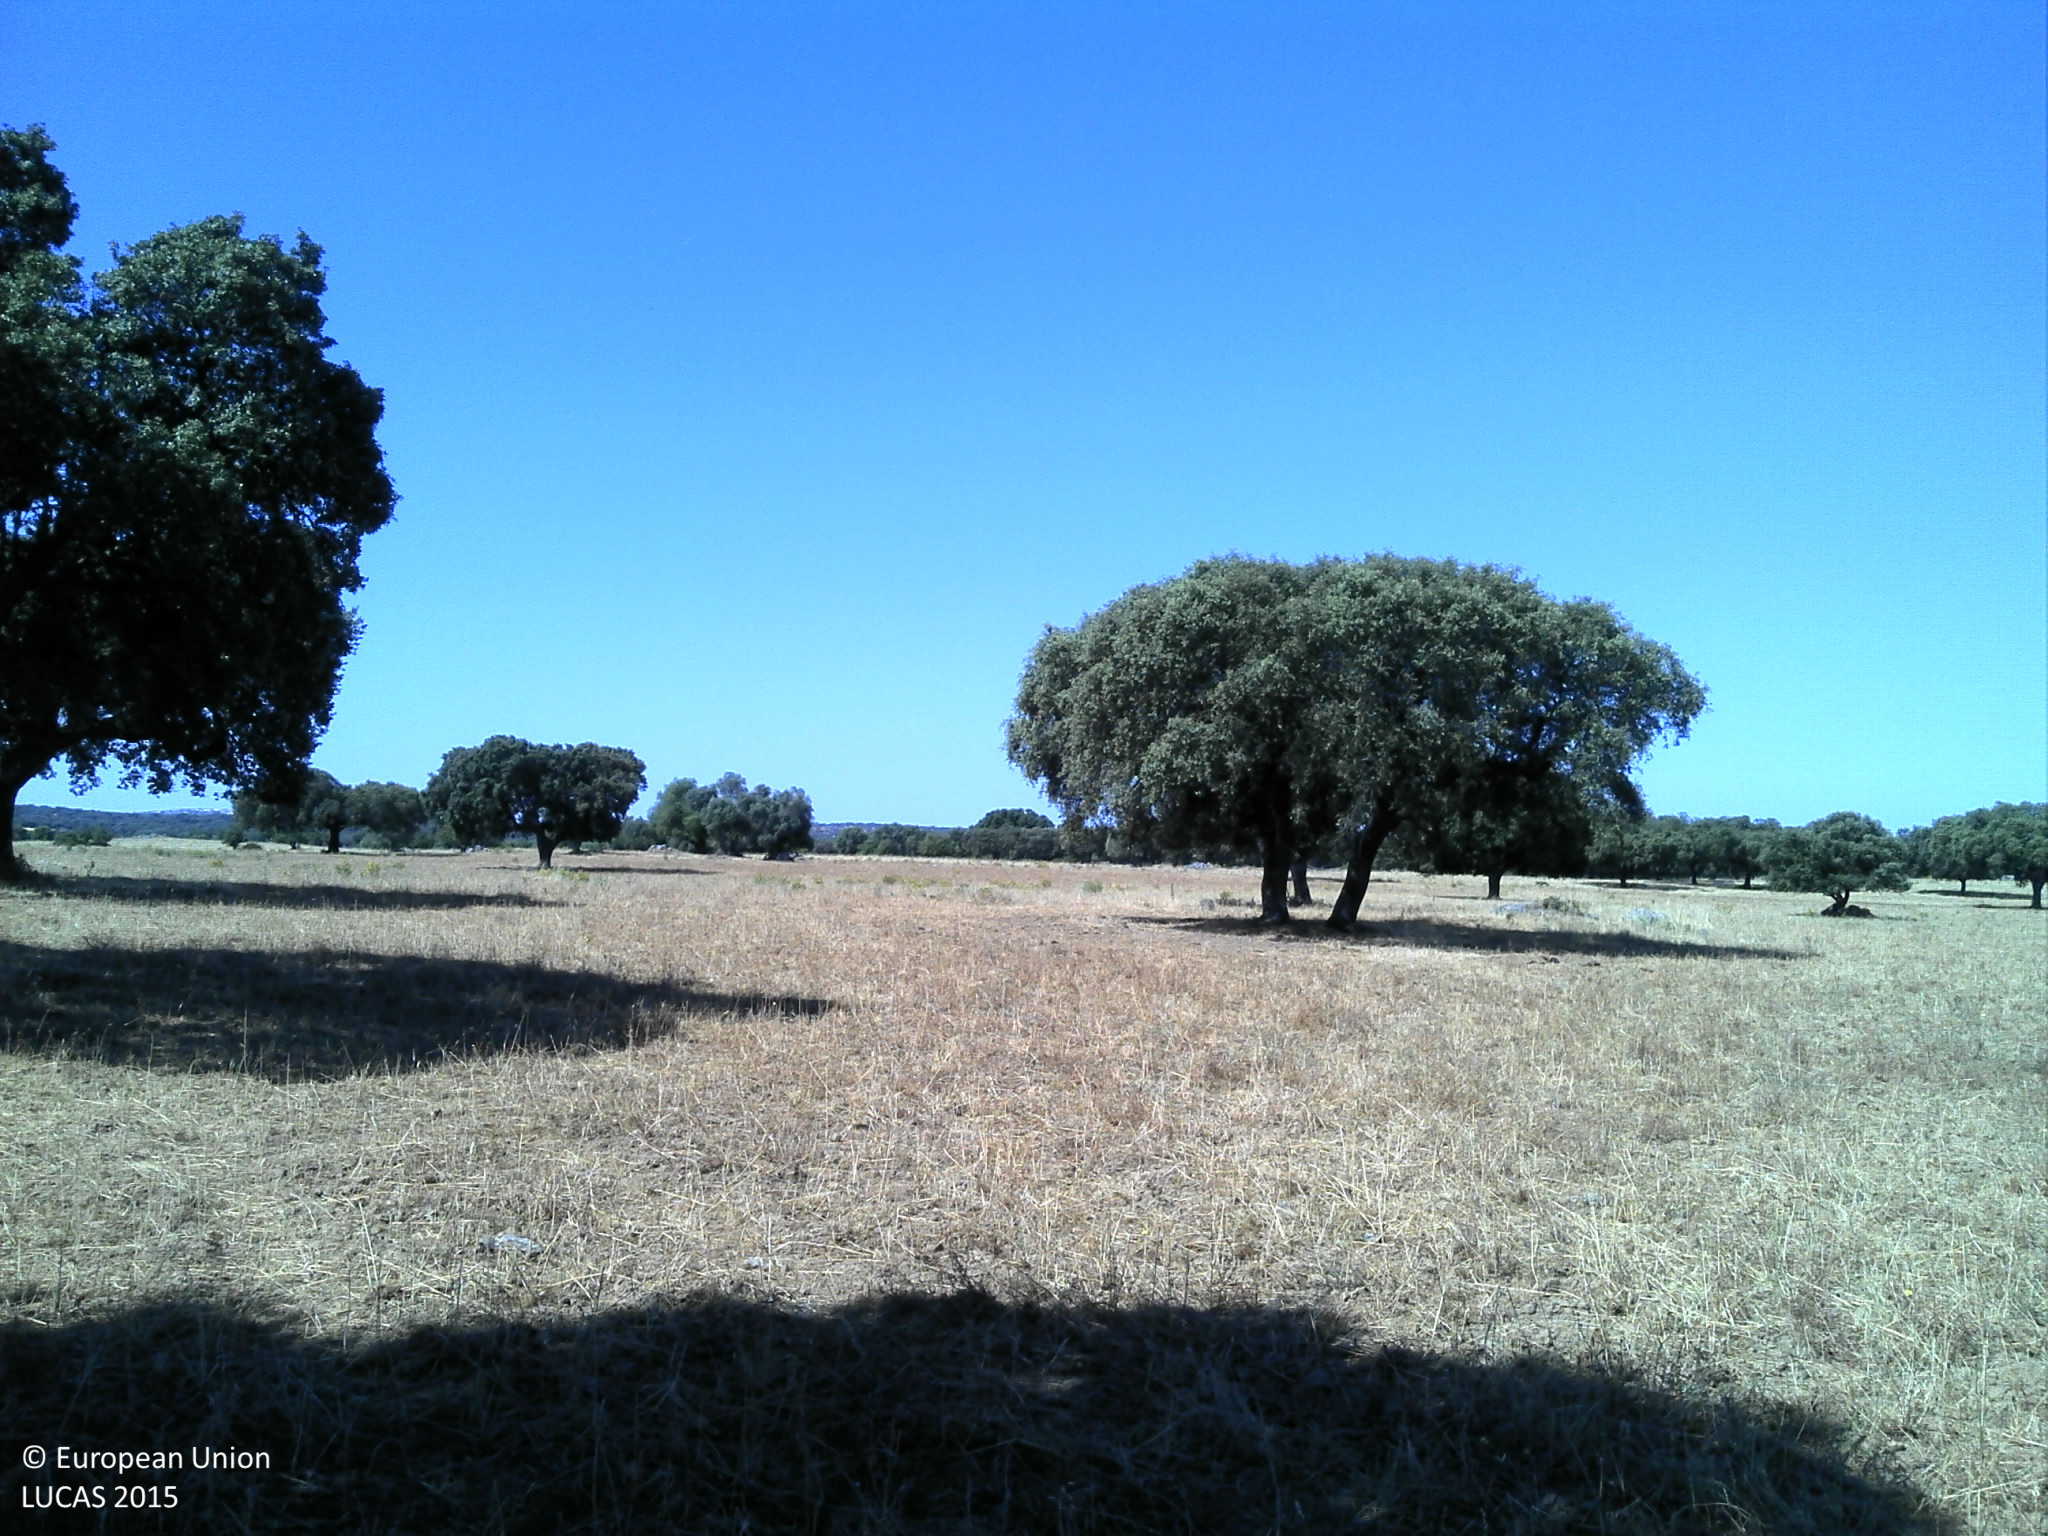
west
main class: Woodland
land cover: Broadleaved woodland
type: broadleaved evergreen forest
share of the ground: 10 - 25 %
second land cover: Grassland without tree/shrub cover
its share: 10 - 25 %
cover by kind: unconsolidated bare surface 70 %, broadleaved forest trees 15 %, herbaceous plants 15 %
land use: Forestry
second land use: Agriculture (excluding fallow land and kitchen gardens)
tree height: > 5 m
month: June
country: PT
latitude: 38.4544
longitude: -8.1134
